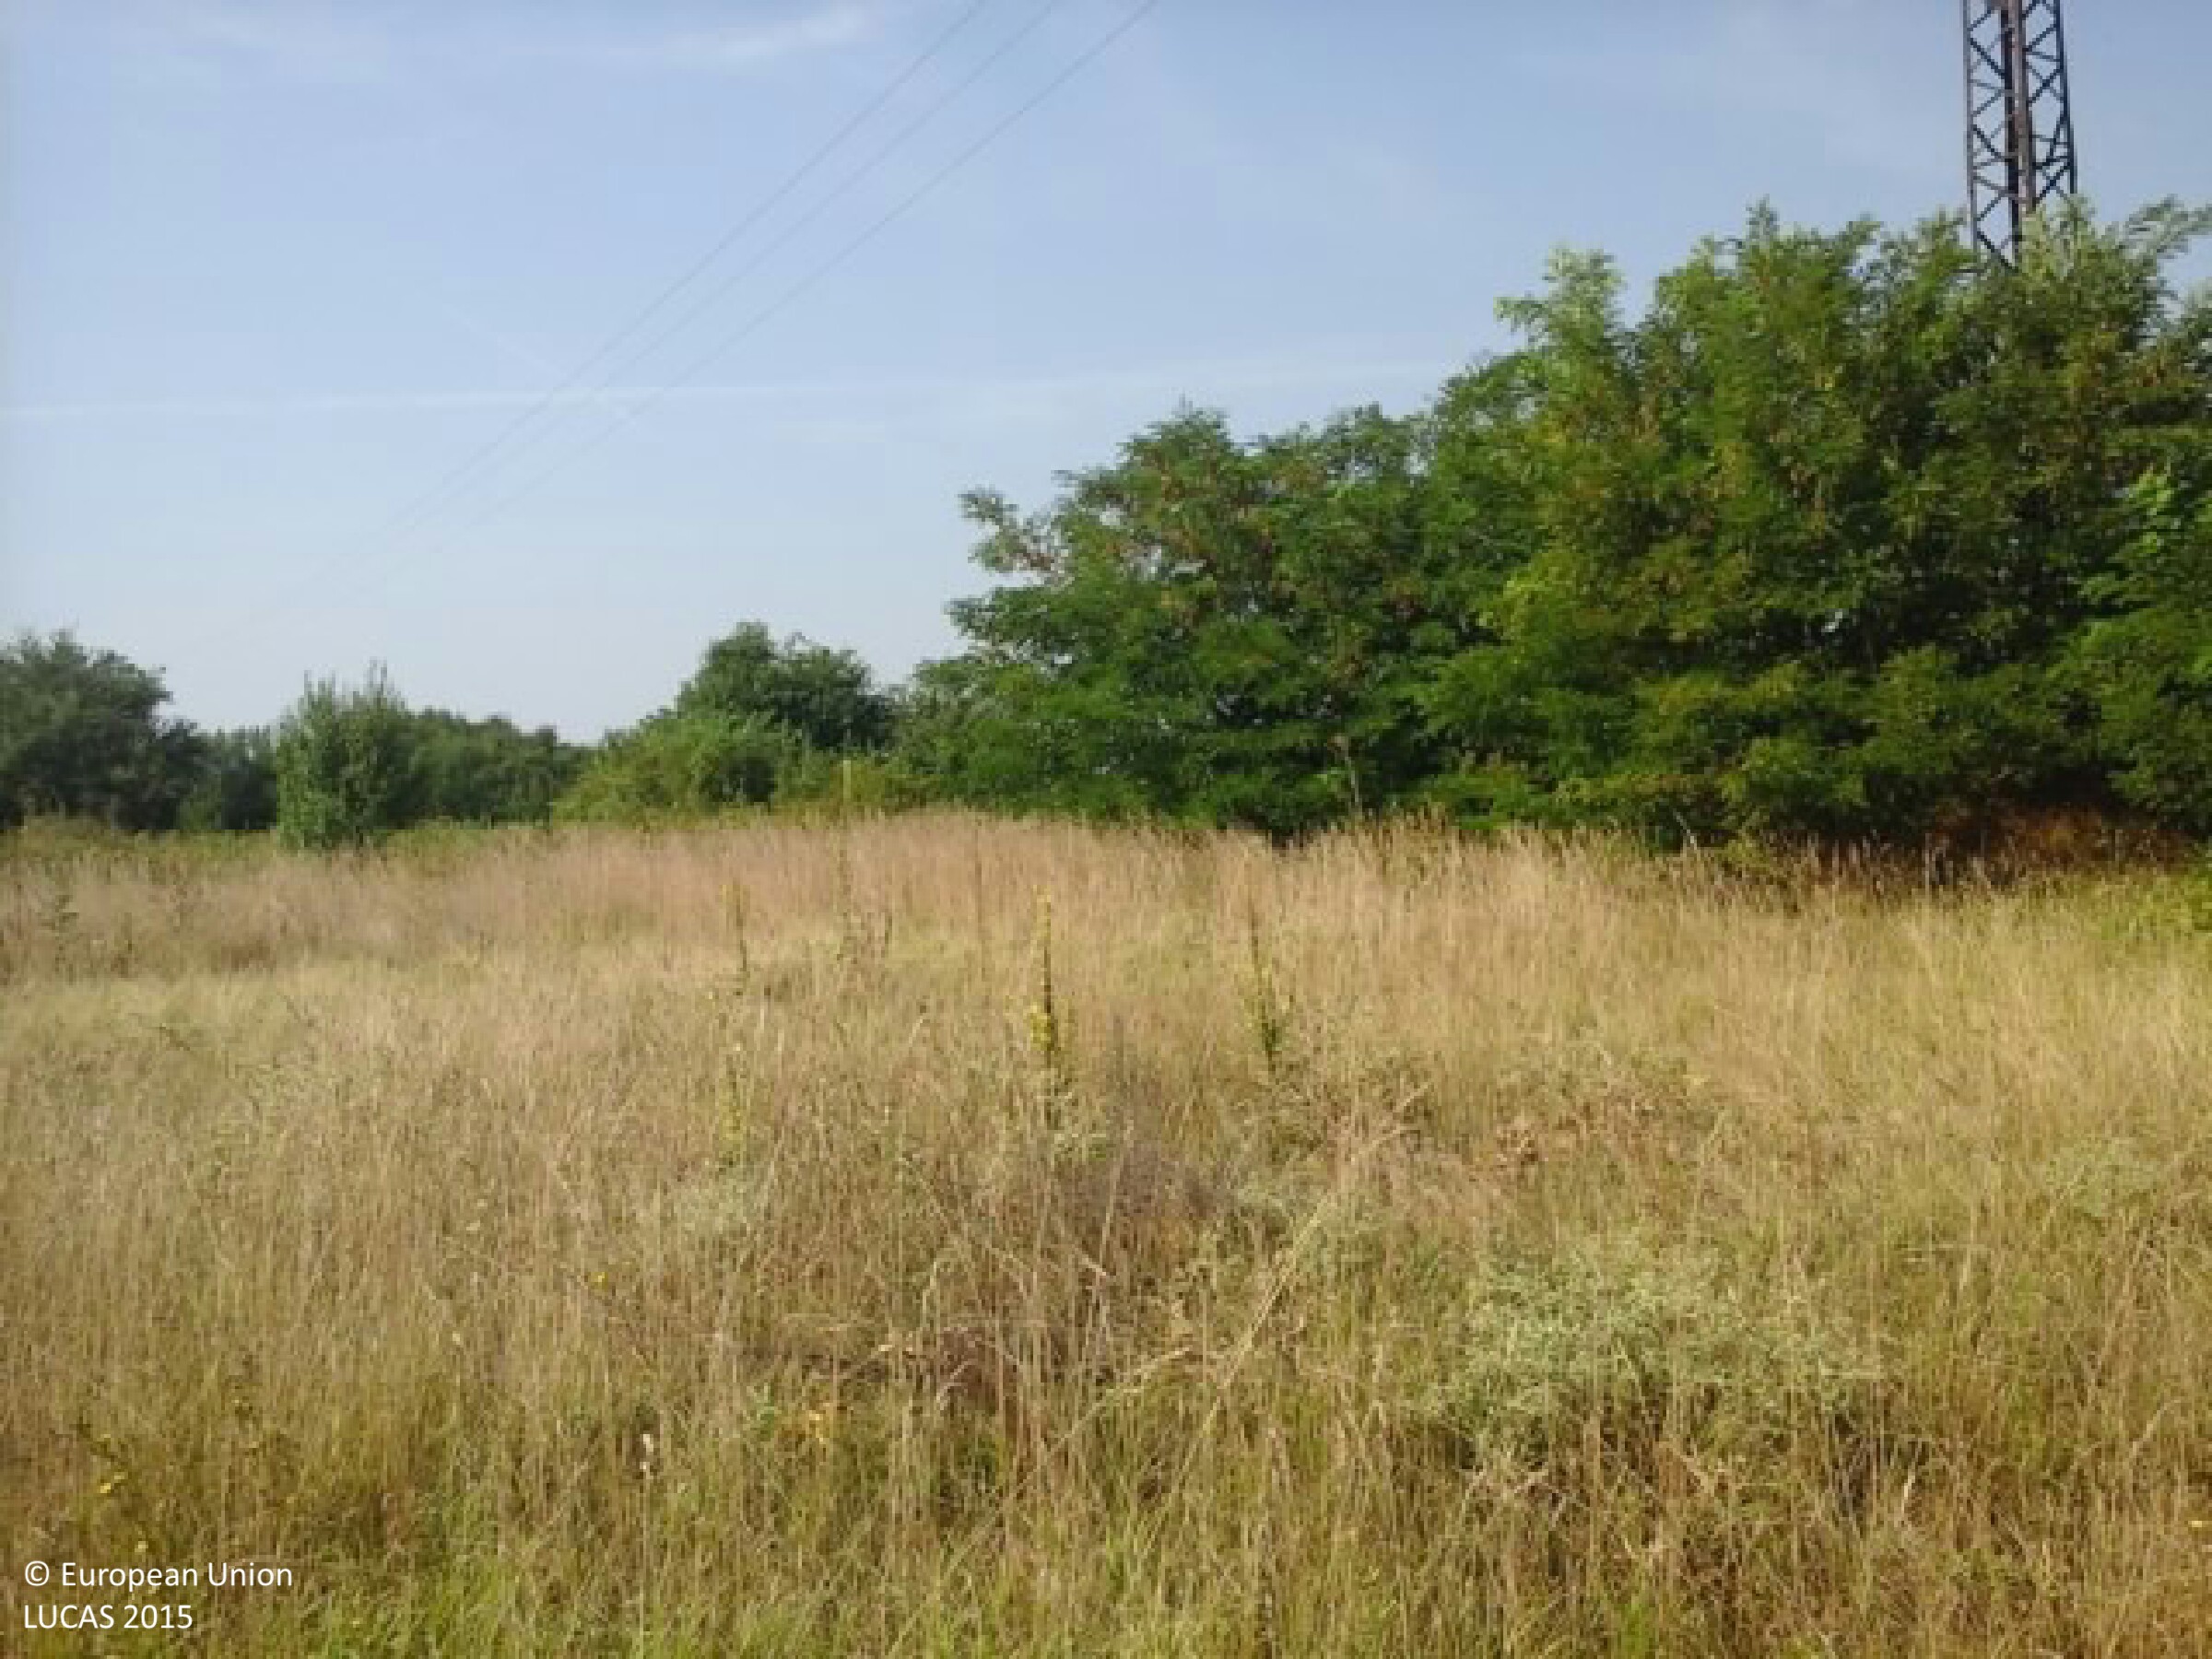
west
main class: Cropland
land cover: Cherry fruit
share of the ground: 50 - 75 %
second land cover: Other bare soil
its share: > 75 %
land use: Agriculture (excluding fallow land and kitchen gardens)
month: July
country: HU
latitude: 47.5988
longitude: 20.2567
